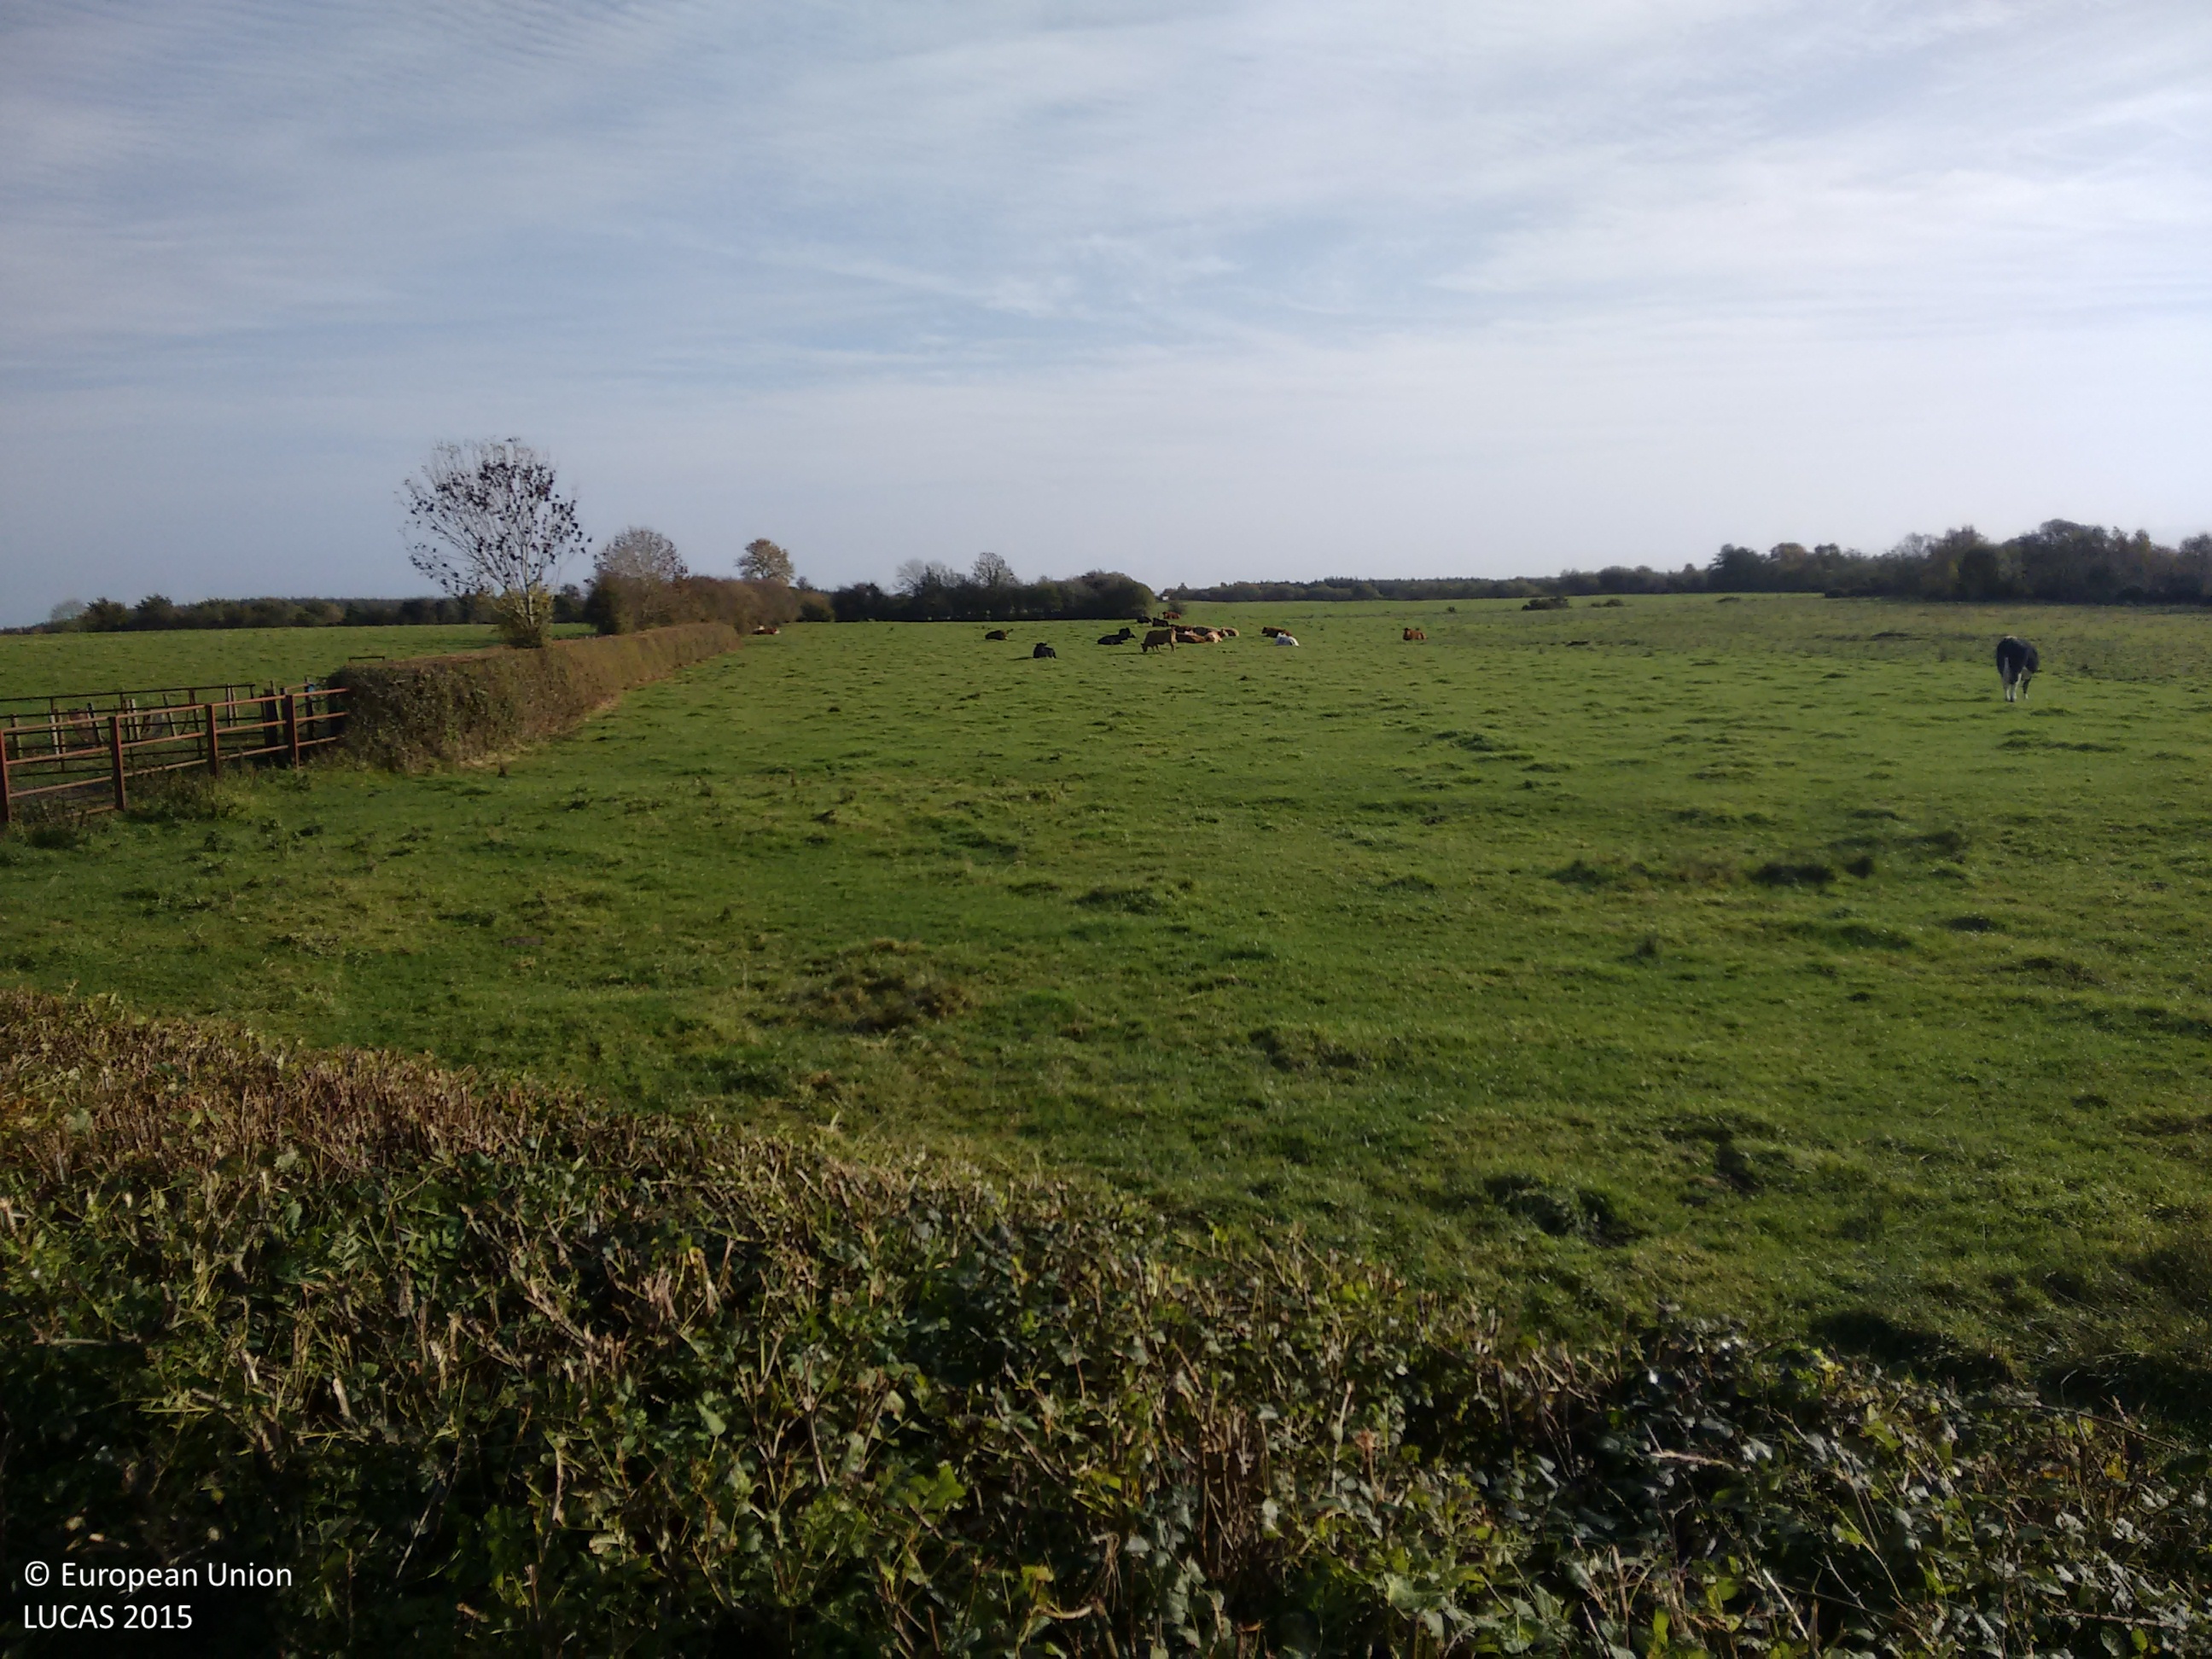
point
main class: Grassland
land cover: Grassland without tree/shrub cover
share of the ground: > 75 %
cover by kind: herbaceous plants 95 %, shrubs 5 %
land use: Agriculture (excluding fallow land and kitchen gardens)
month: October
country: IE
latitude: 53.2376
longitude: -7.8658
